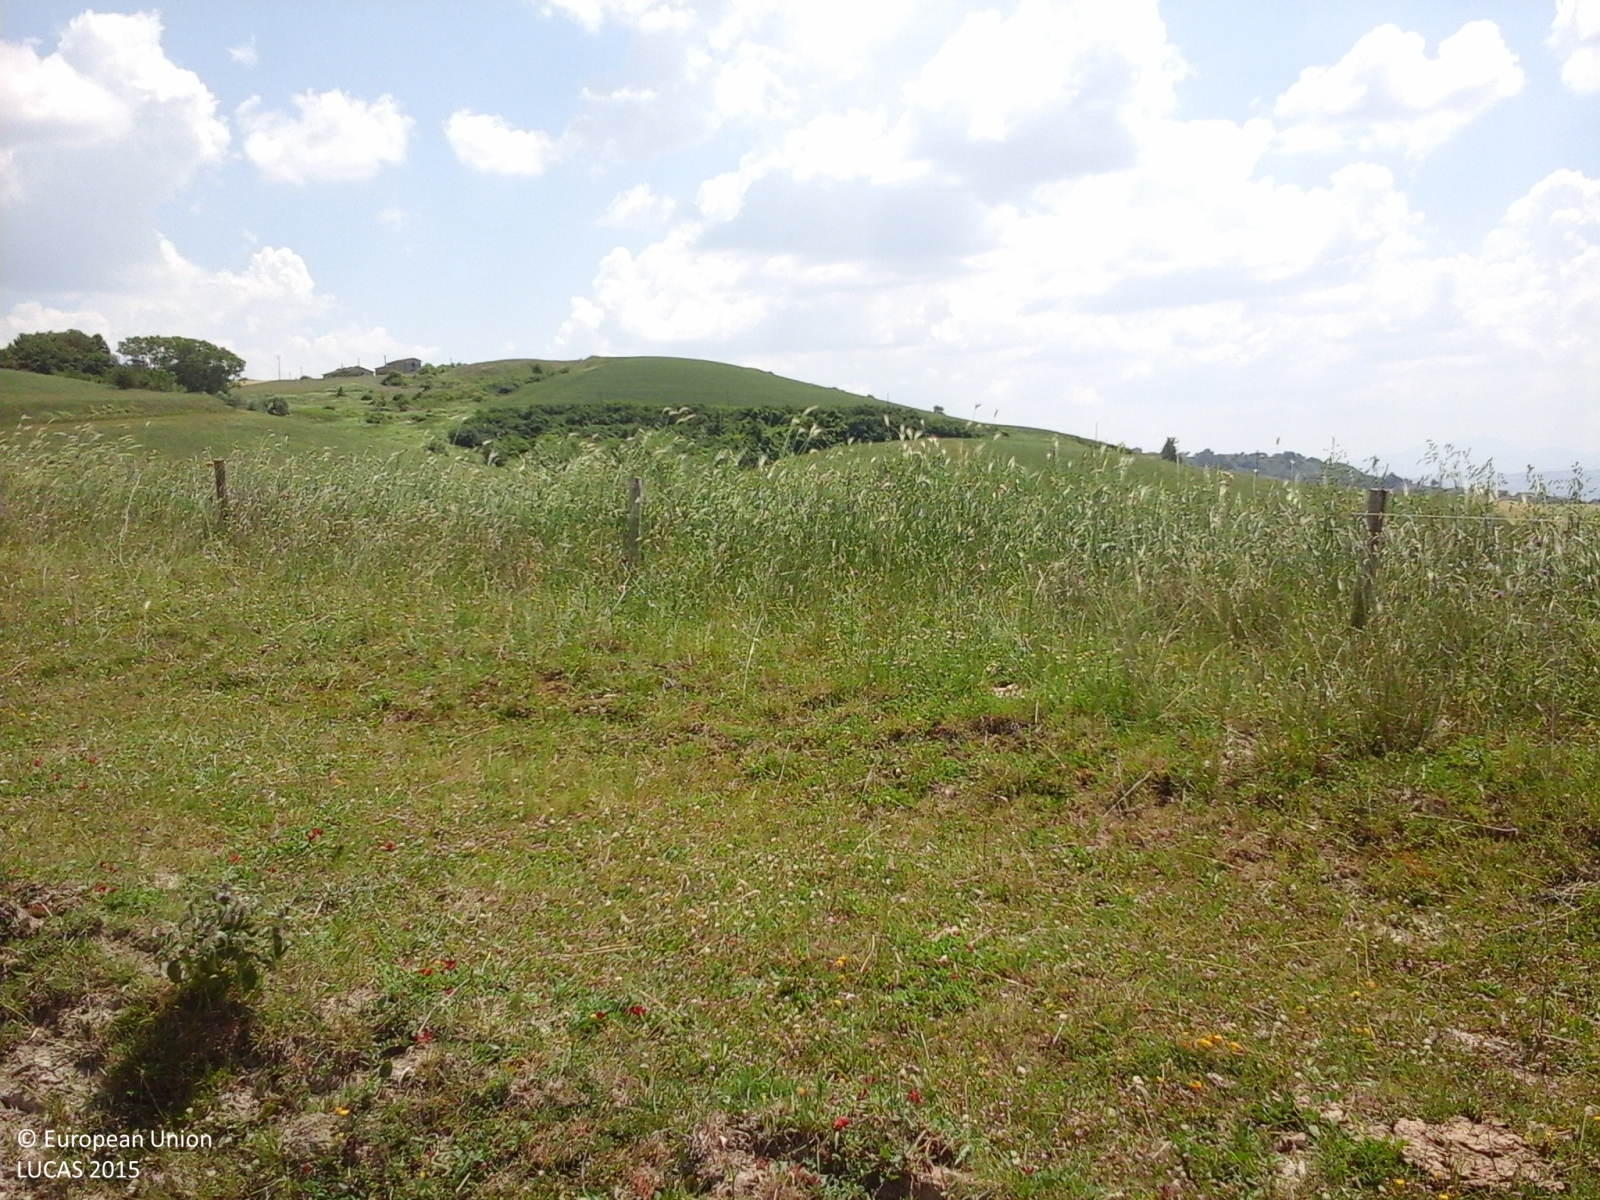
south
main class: Grassland
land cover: Grassland without tree/shrub cover
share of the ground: > 75 %
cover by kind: herbaceous plants 100 %
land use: Agriculture (excluding fallow land and kitchen gardens)
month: June
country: IT
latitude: 41.1463
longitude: 15.1641
